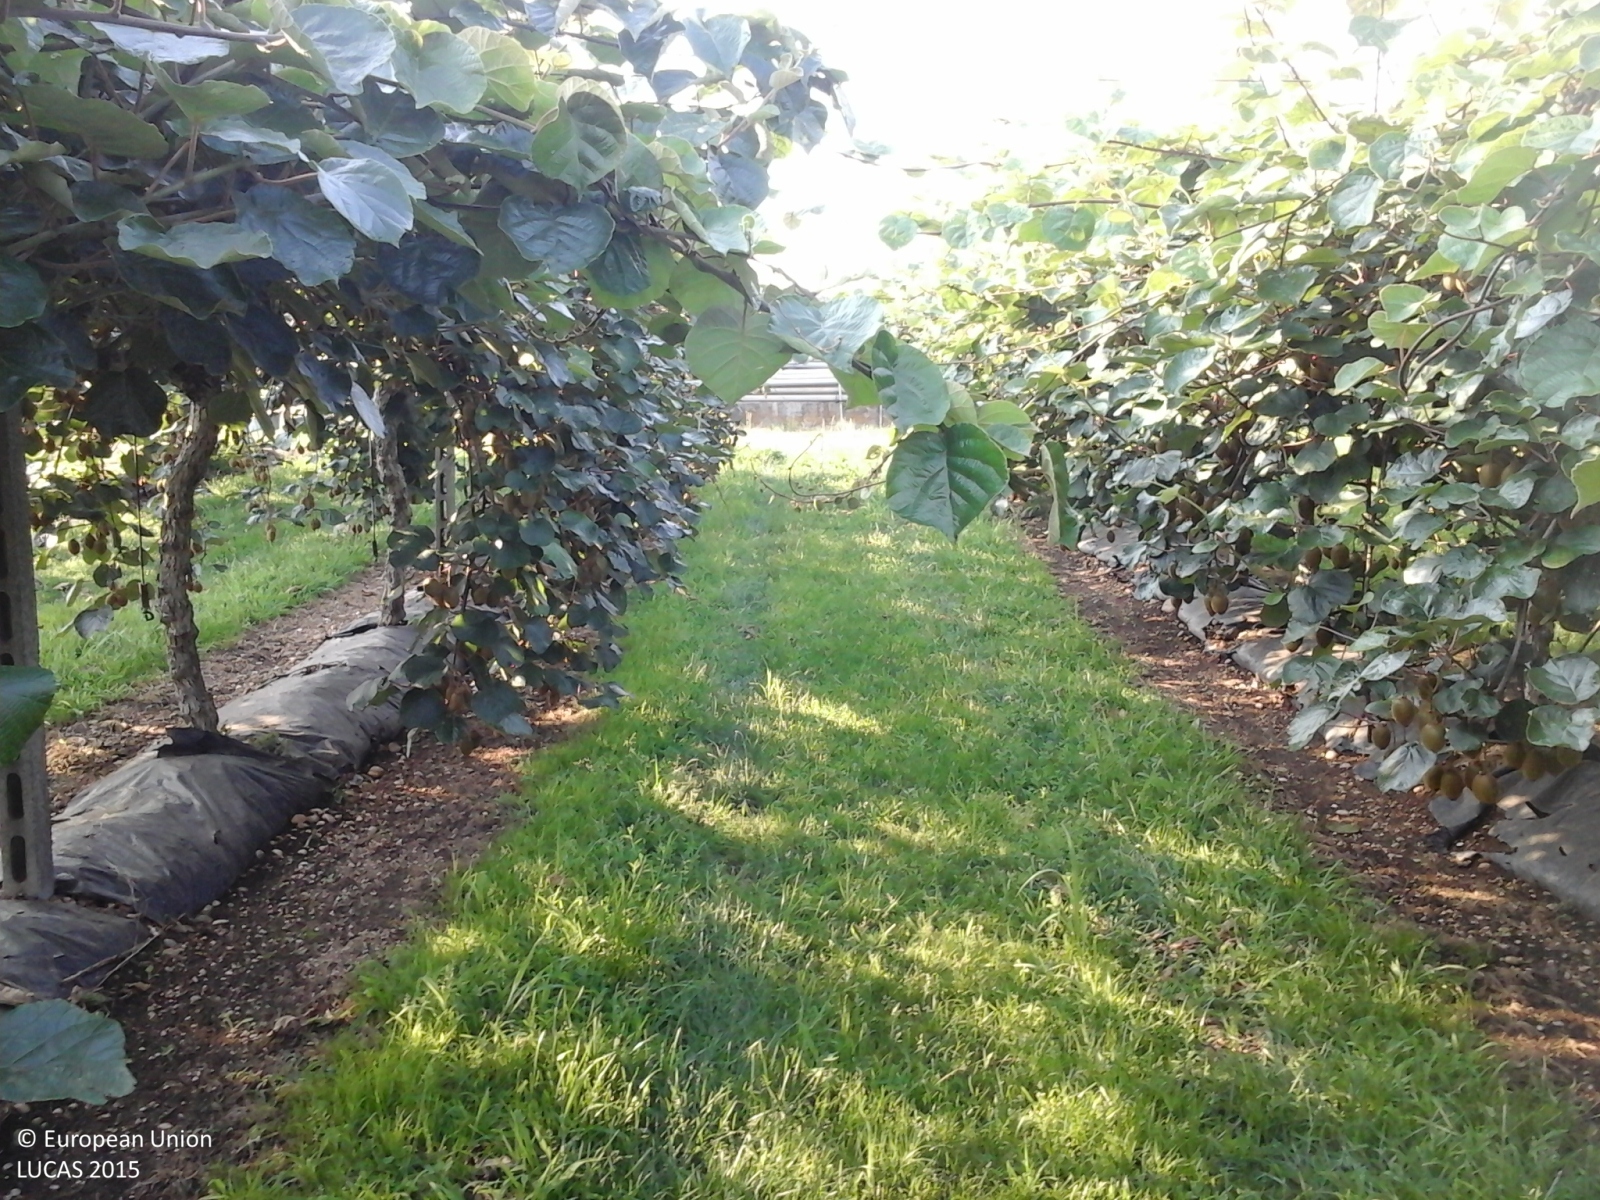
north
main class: Cropland
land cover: Other fruit trees and berries
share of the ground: > 75 %
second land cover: Grassland without tree/shrub cover
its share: > 75 %
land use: Agriculture (excluding fallow land and kitchen gardens)
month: July
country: IT
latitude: 45.3741
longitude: 10.9305
